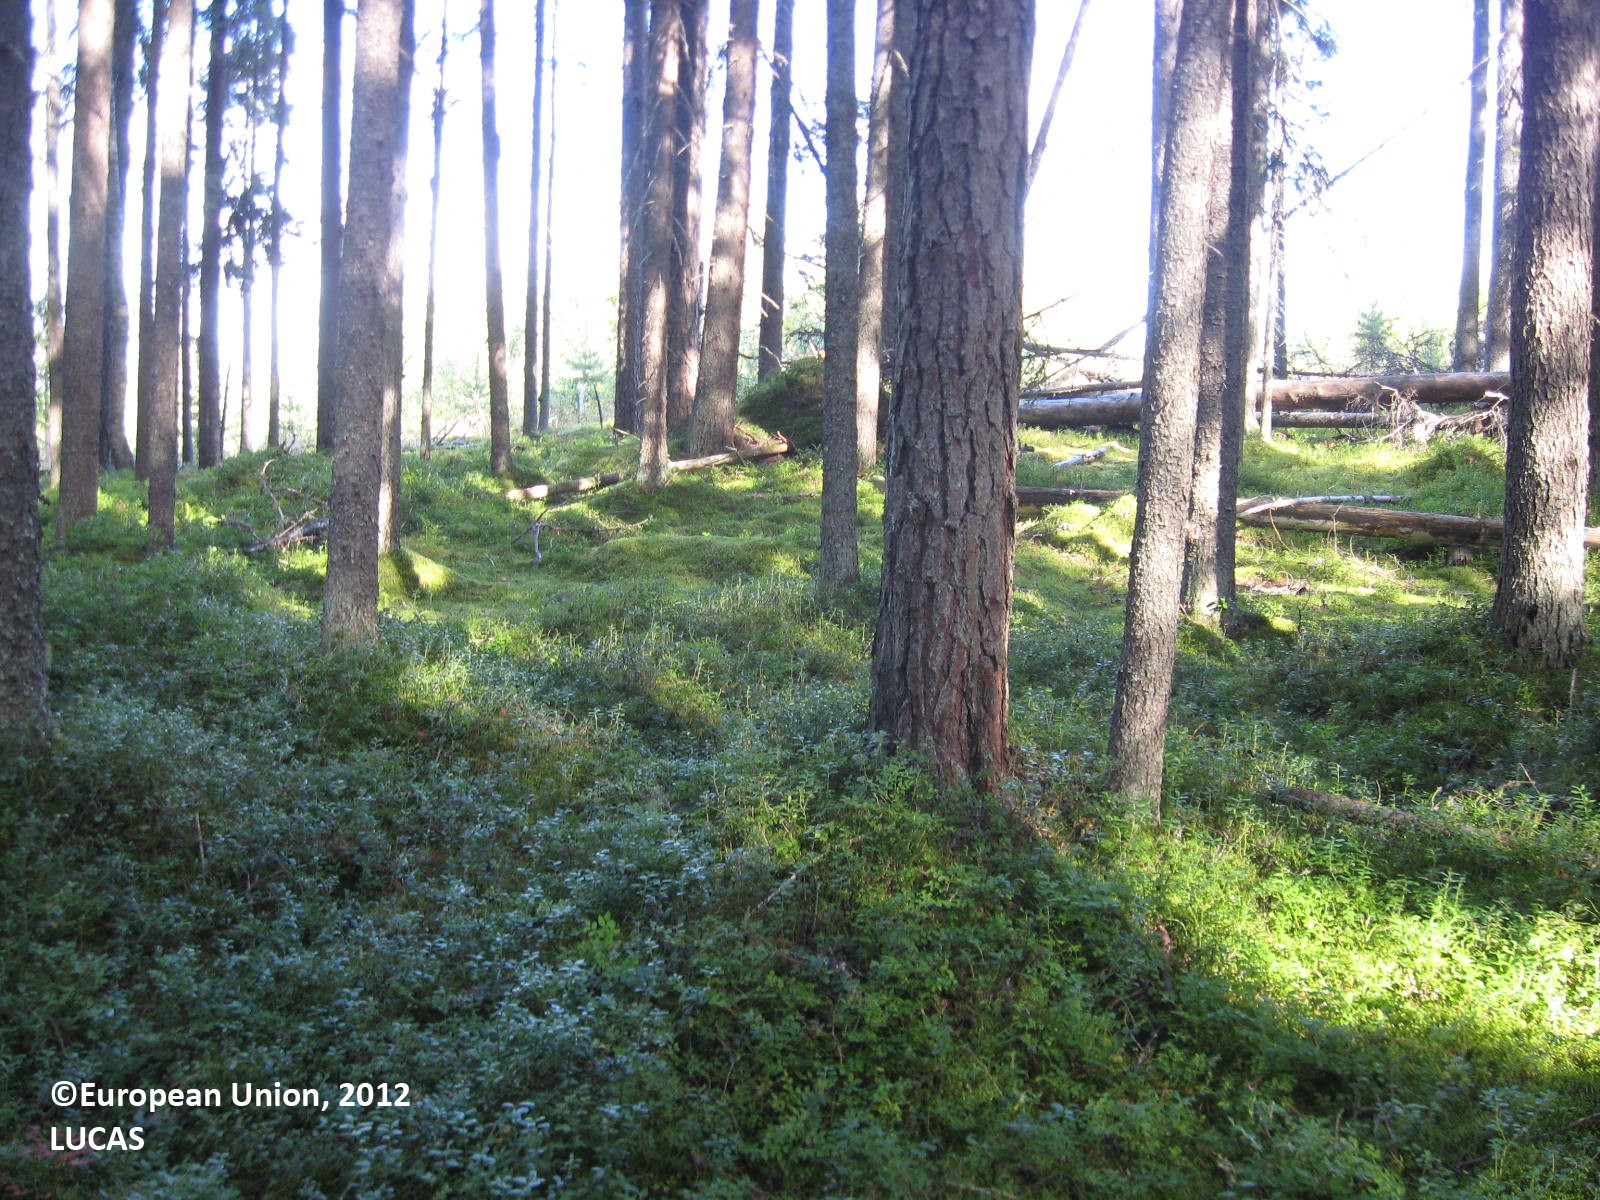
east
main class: Woodland
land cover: Spruce dominated coniferous woodland
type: boreal forest
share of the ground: > 75 %
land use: Forestry
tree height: > 5 m
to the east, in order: Spruce dominated coniferous woodland; Pine dominated mixed woodland
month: August
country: FI
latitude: 63.8606
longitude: 30.0825
